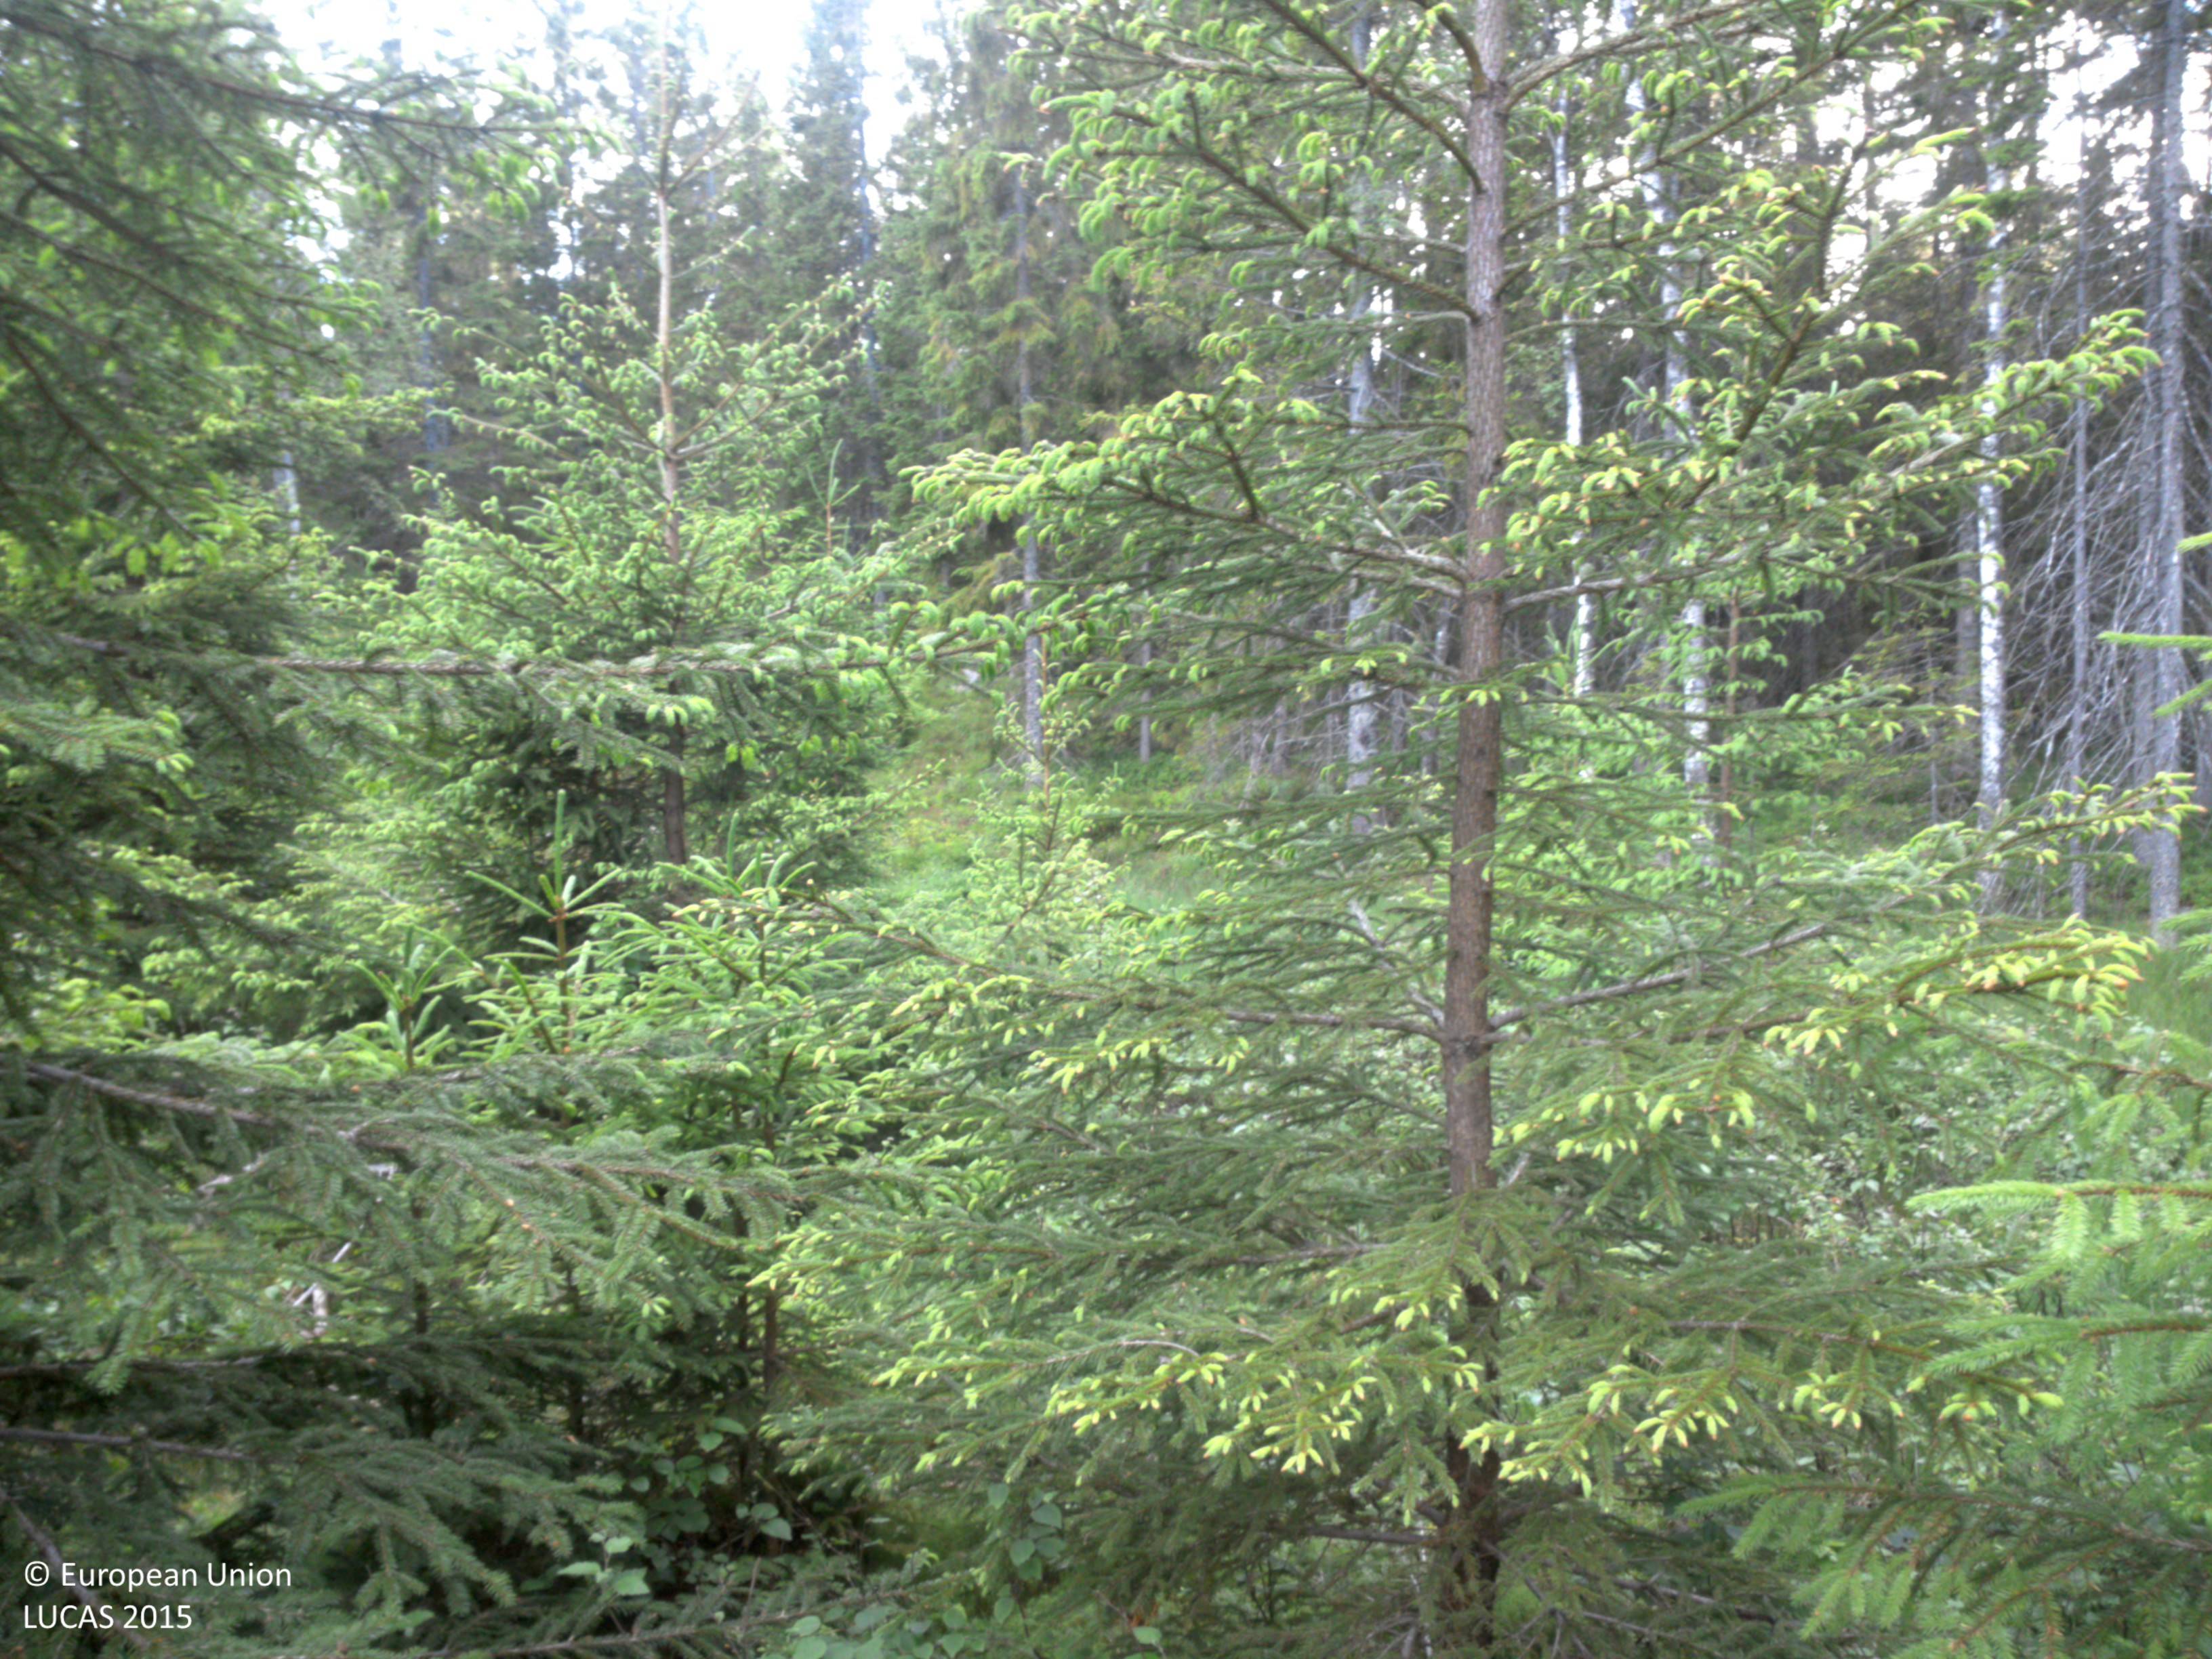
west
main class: Woodland
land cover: Spruce dominated coniferous woodland
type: boreal forest
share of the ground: 50 - 75 %
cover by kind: coniferous forest trees 55 %, herbaceous plants 40 %, broadleaved forest trees 5 %
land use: Forestry
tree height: > 5 m
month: June
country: SE
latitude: 58.8662
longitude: 12.2665
